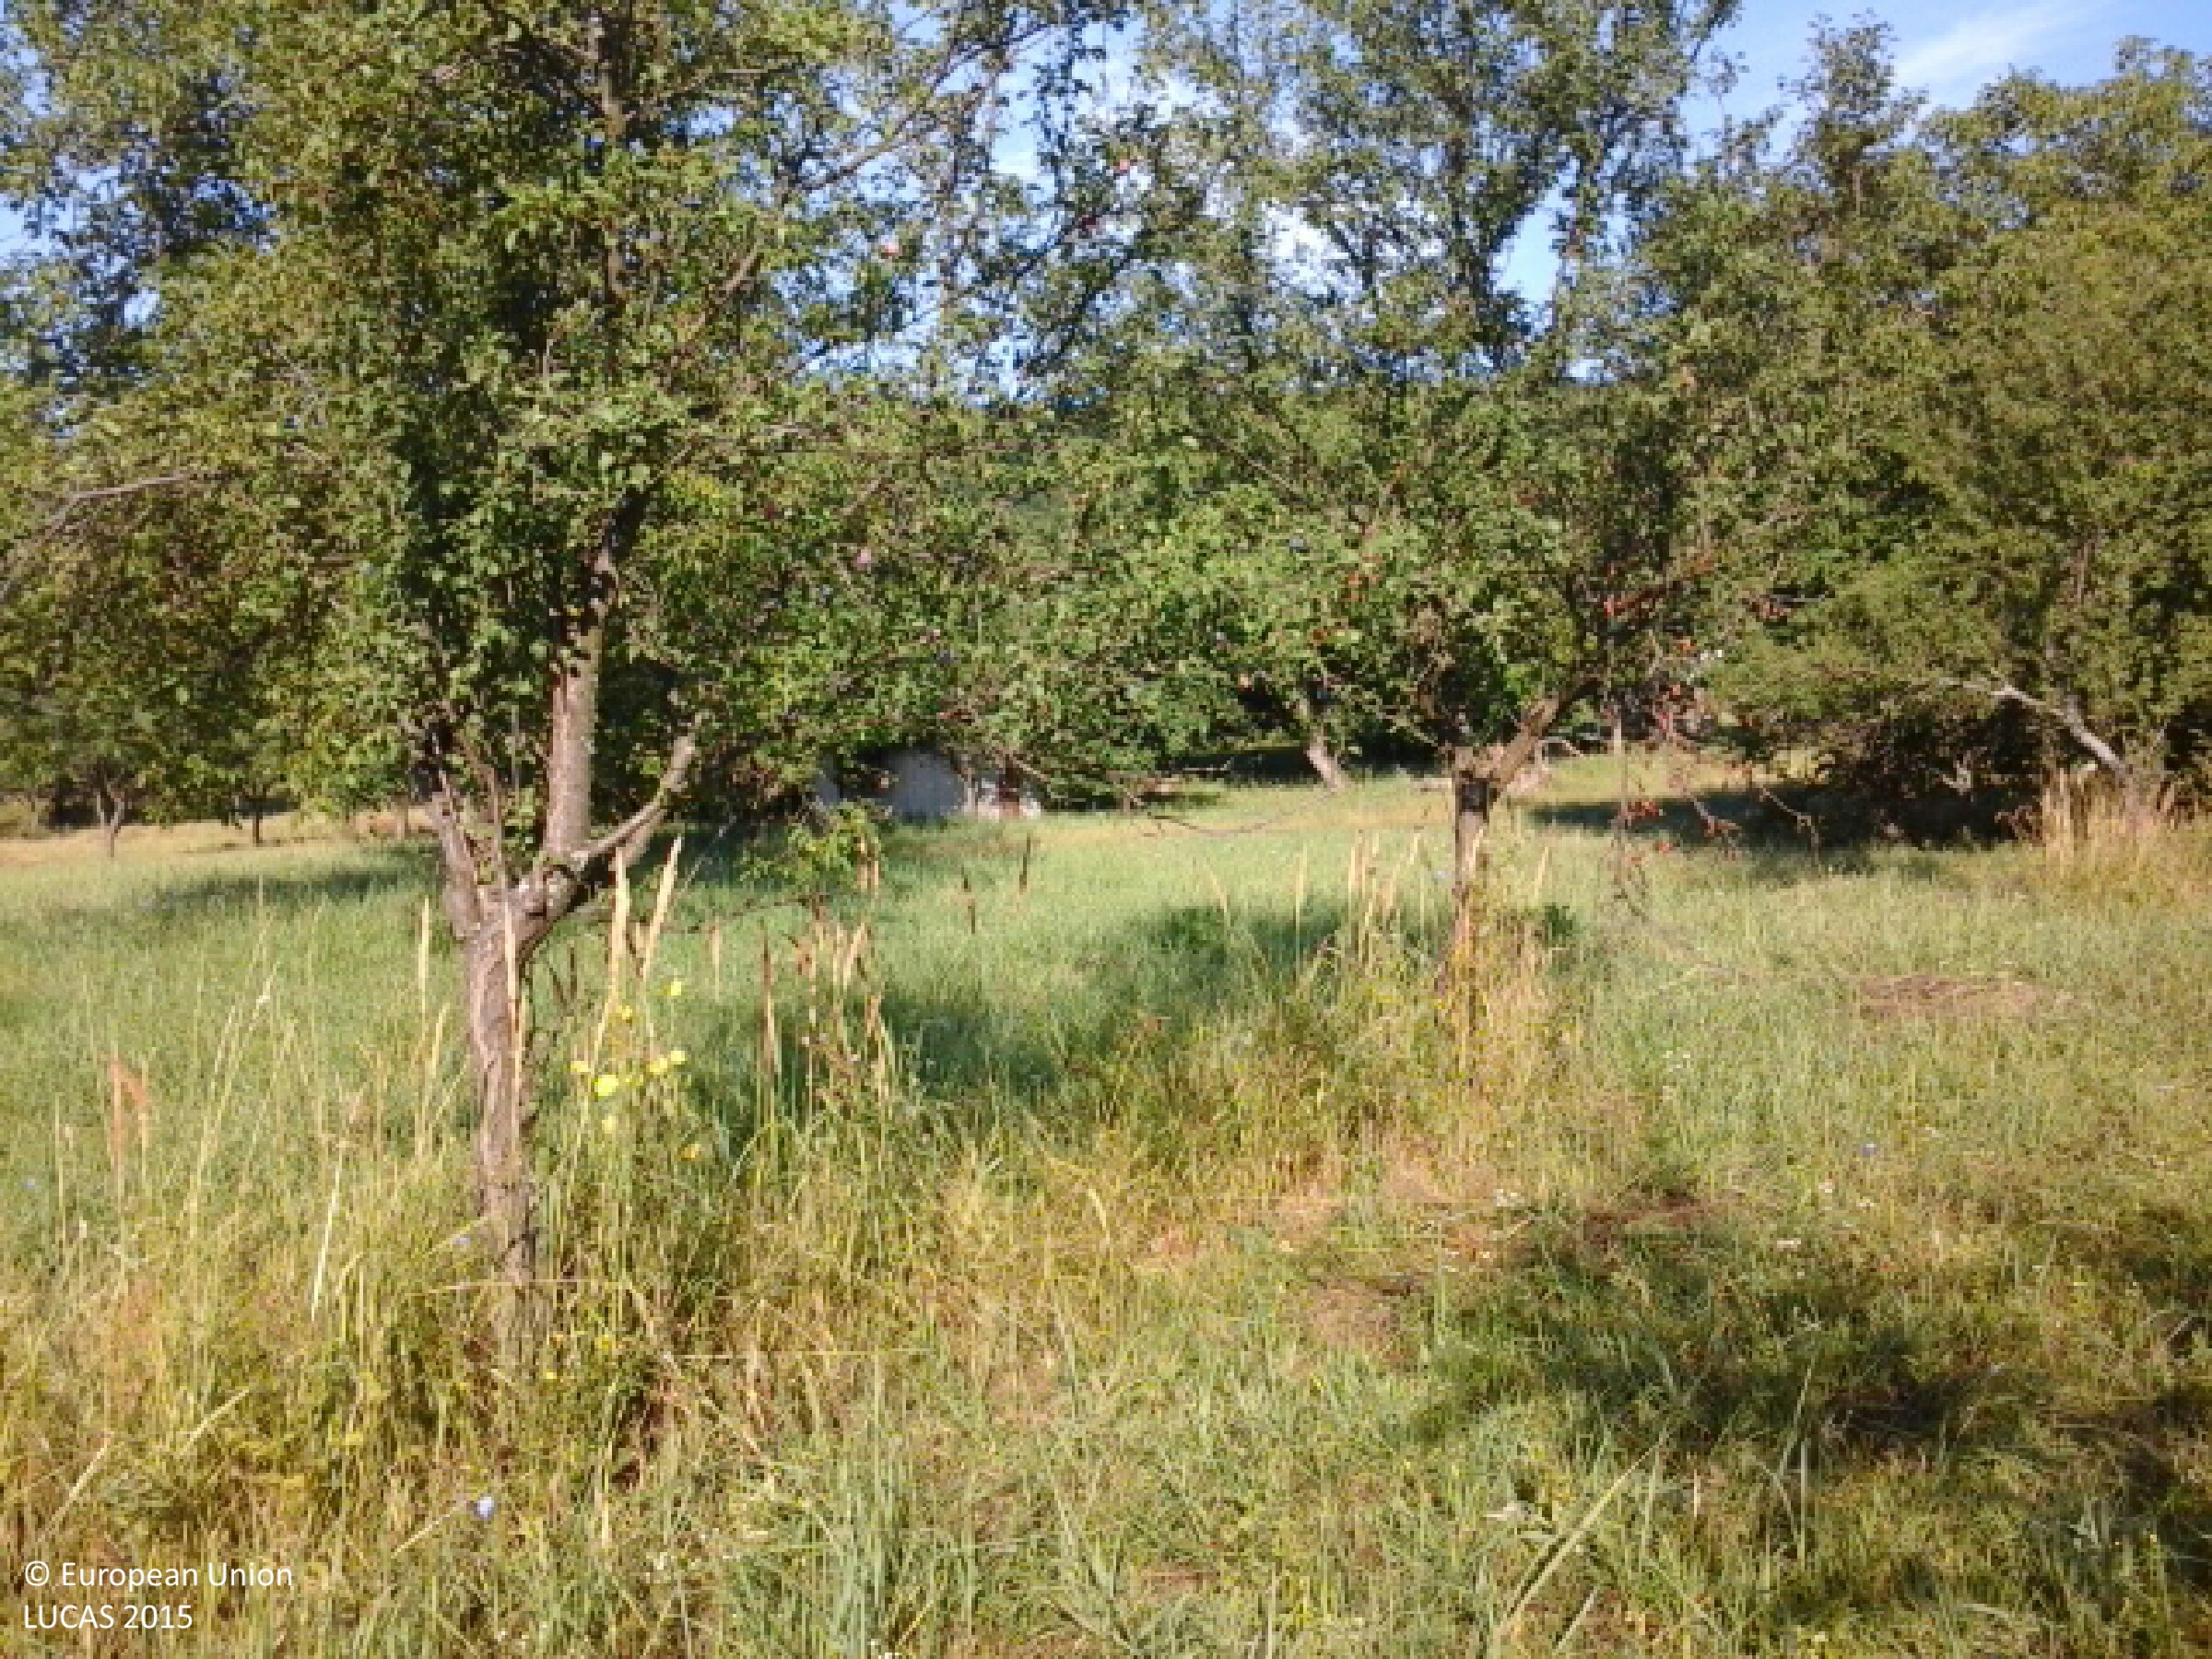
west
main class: Cropland
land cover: Other fruit trees and berries
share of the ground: 10 - 25 %
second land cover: Grassland without tree/shrub cover
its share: > 75 %
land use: Agriculture (excluding fallow land and kitchen gardens)
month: July
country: HU
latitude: 48.3584
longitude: 21.5596
